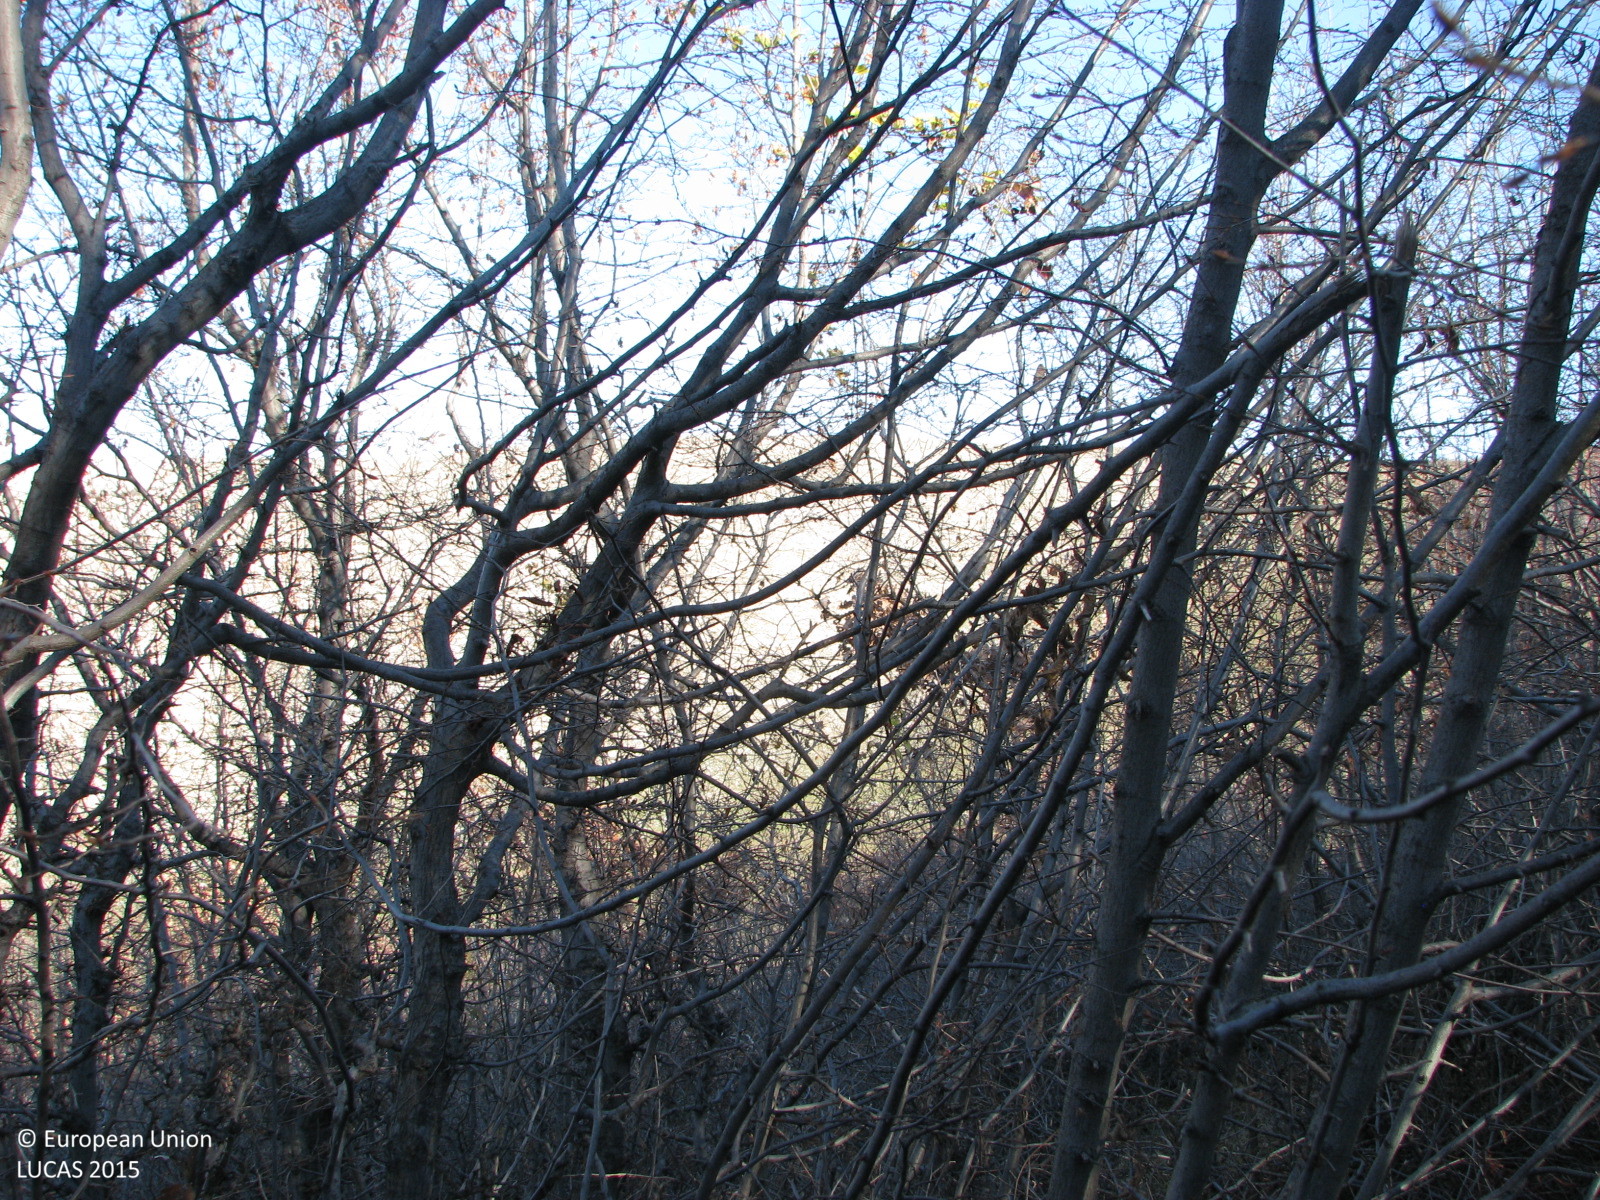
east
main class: Woodland
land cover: Broadleaved woodland
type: mesophytic deciduous forest
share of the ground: > 75 %
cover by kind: broadleaved forest trees 90 %, shrubs 5 %, unconsolidated bare surface 5 %
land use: Semi-natural and natural areas not in use
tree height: < 5 m
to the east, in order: Broadleaved woodland; Grassland without tree/shrub cover; Tracks; Grassland with sparse tree/shrub cover; Shrubland without tree cover; Grassland without tree/shrub cover
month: December
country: BG
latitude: 42.1474
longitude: 24.1630
